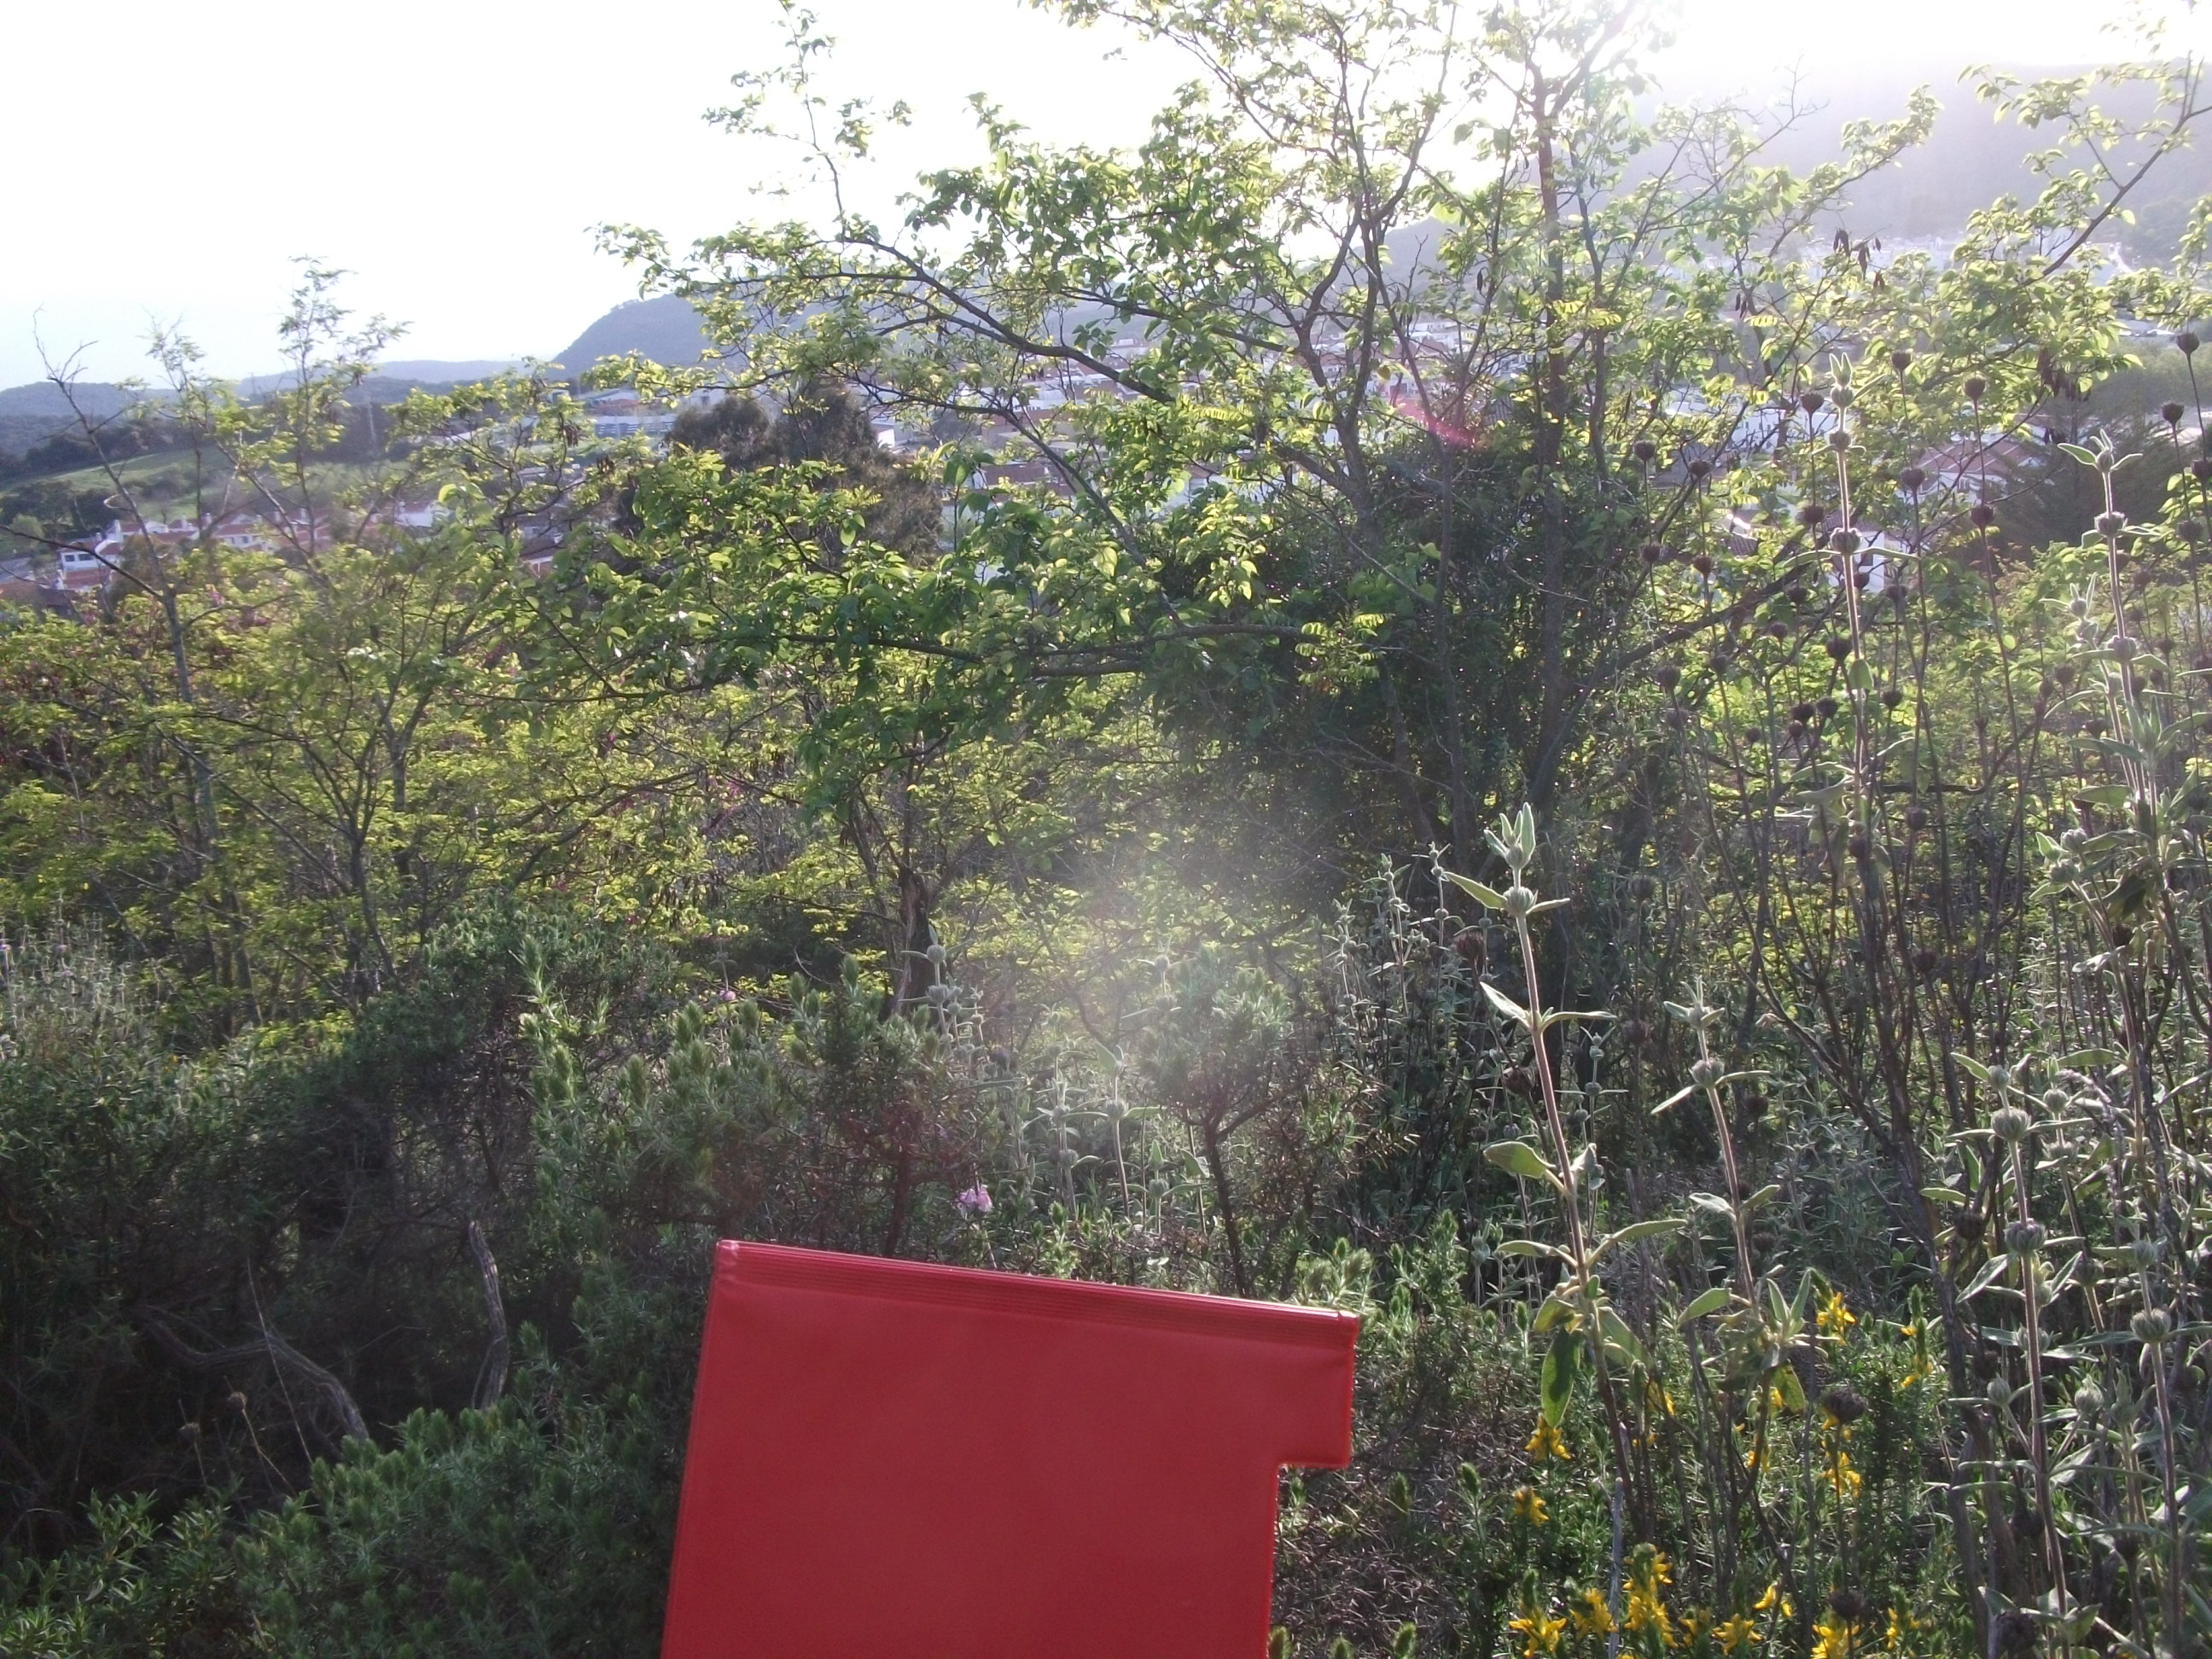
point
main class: Woodland
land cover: Other mixed woodland
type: coniferous forest of the mediterranean region
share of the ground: 25 - 50 %
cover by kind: shrubs 45 %, coniferous forest trees 25 %, broadleaved forest trees 20 %, herbaceous plants 10 %
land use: Semi-natural and natural areas not in use
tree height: > 5 m
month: April
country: ES
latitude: 37.8894
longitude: -6.5652
